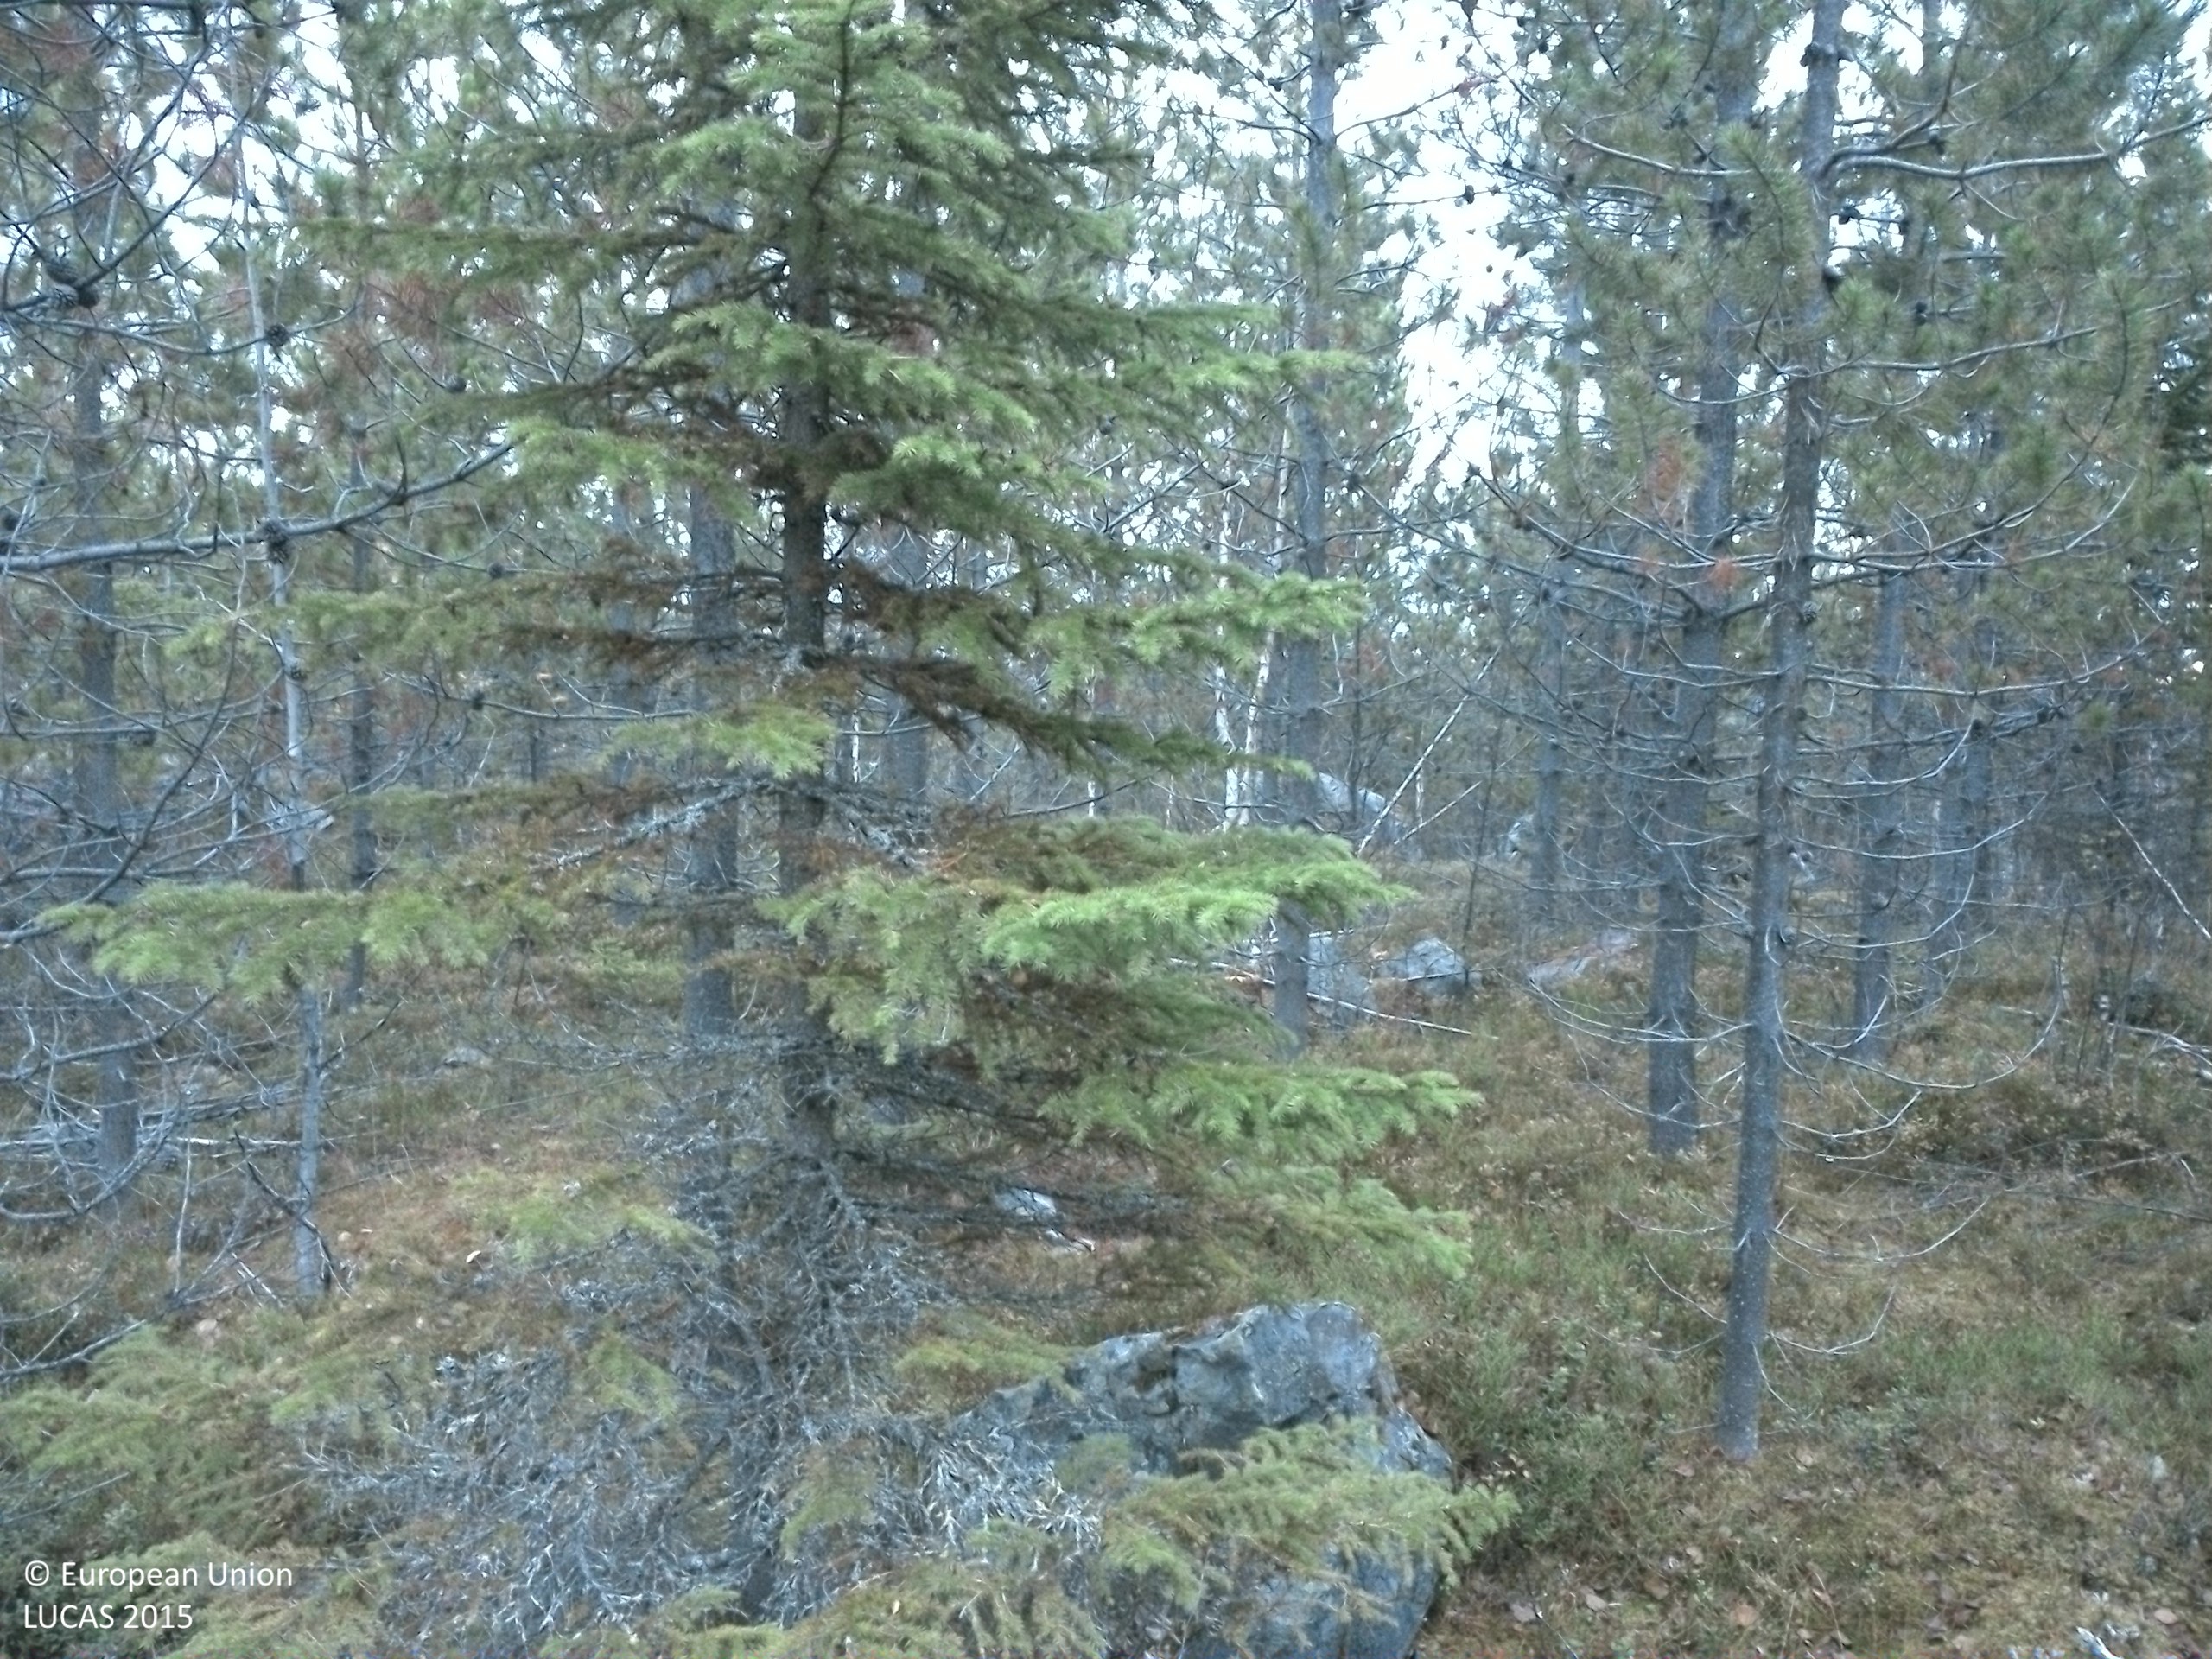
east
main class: Woodland
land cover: Pine dominated coniferous woodland
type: exotic forest
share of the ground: 50 - 75 %
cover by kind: coniferous forest trees 45 %, shrubs 30 %, lichens and mosses 15 %, broadleaved forest trees 5 %, consolidated bare surface 5 %
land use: Forestry
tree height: > 5 m
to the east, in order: Pine dominated coniferous woodland; Pine dominated mixed woodland; Spruce dominated mixed woodland; Pine dominated mixed woodland; Spruce dominated mixed woodland; Pine dominated mixed woodland; Spruce dominated mixed woodland; Rivers and streams; Spruce dominated mixed woodland
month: October
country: SE
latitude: 64.4290
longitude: 15.5146
